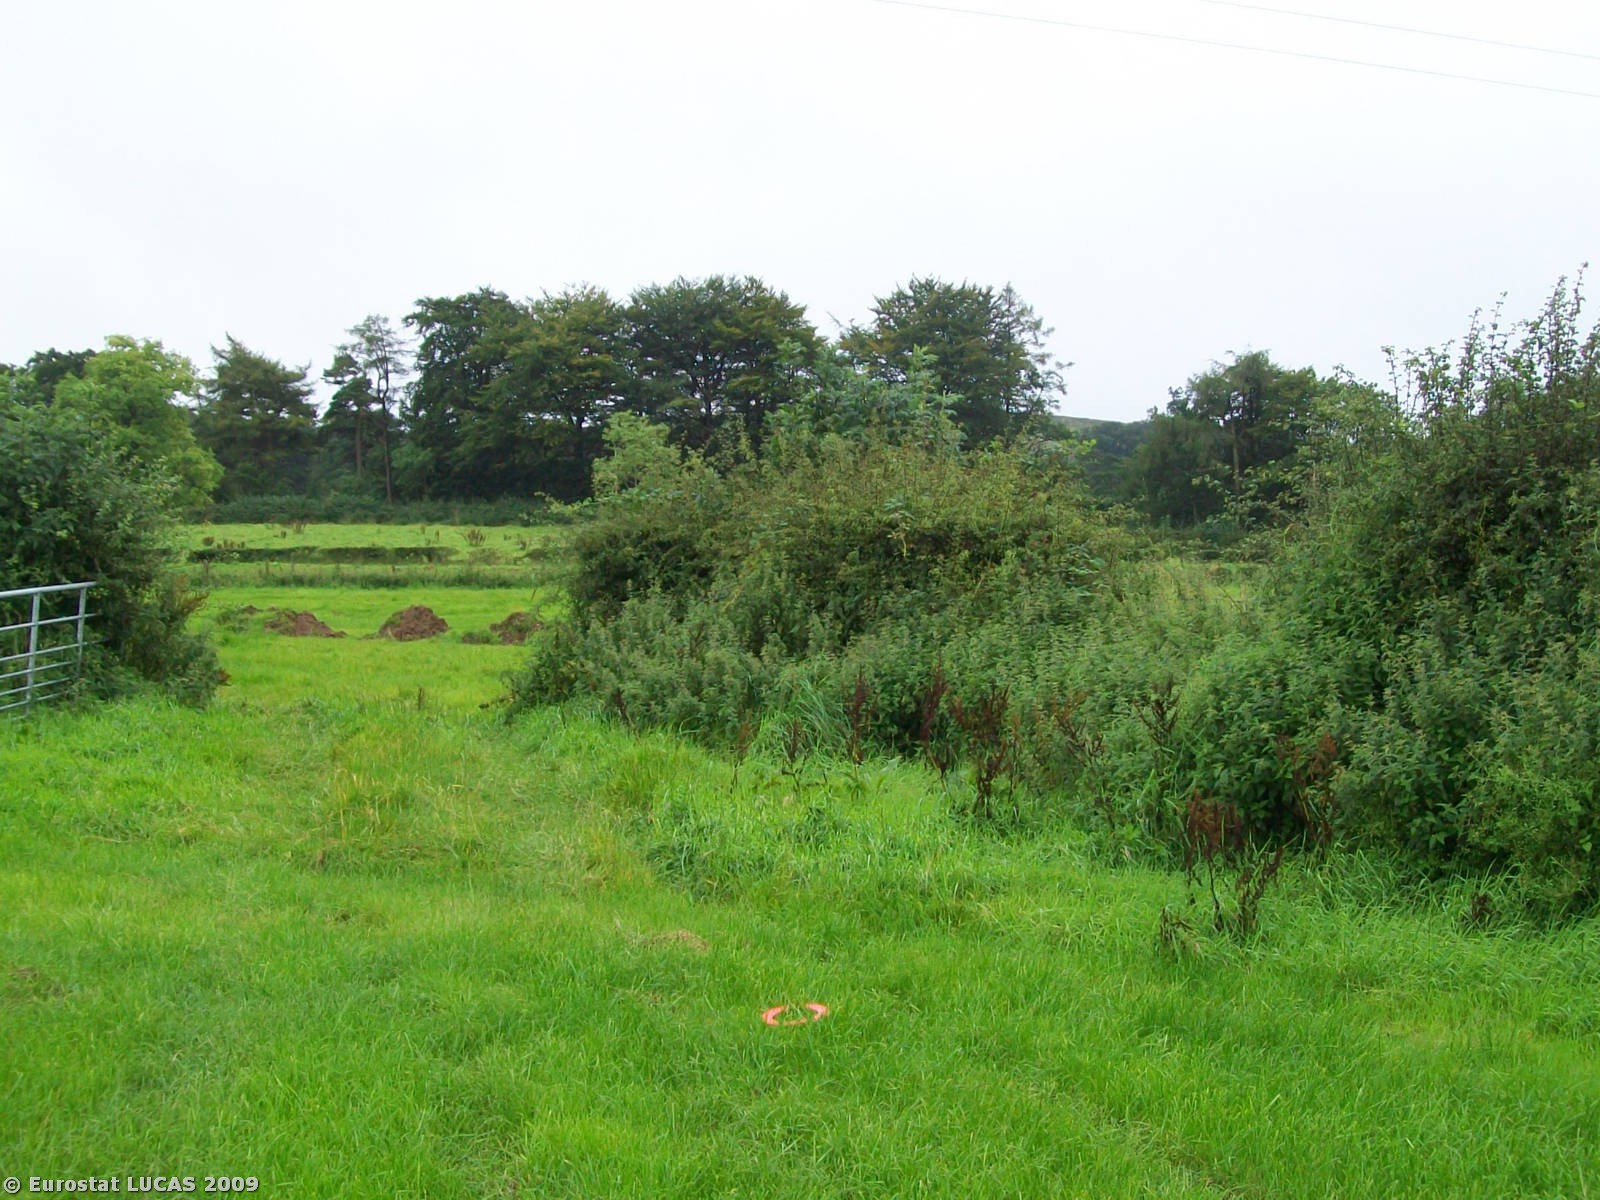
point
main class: Grassland
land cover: Grassland without tree/shrub cover
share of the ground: > 75 %
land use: Agriculture (excluding fallow land and kitchen gardens)
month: August
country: GB
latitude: 54.6089
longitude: -6.1061
